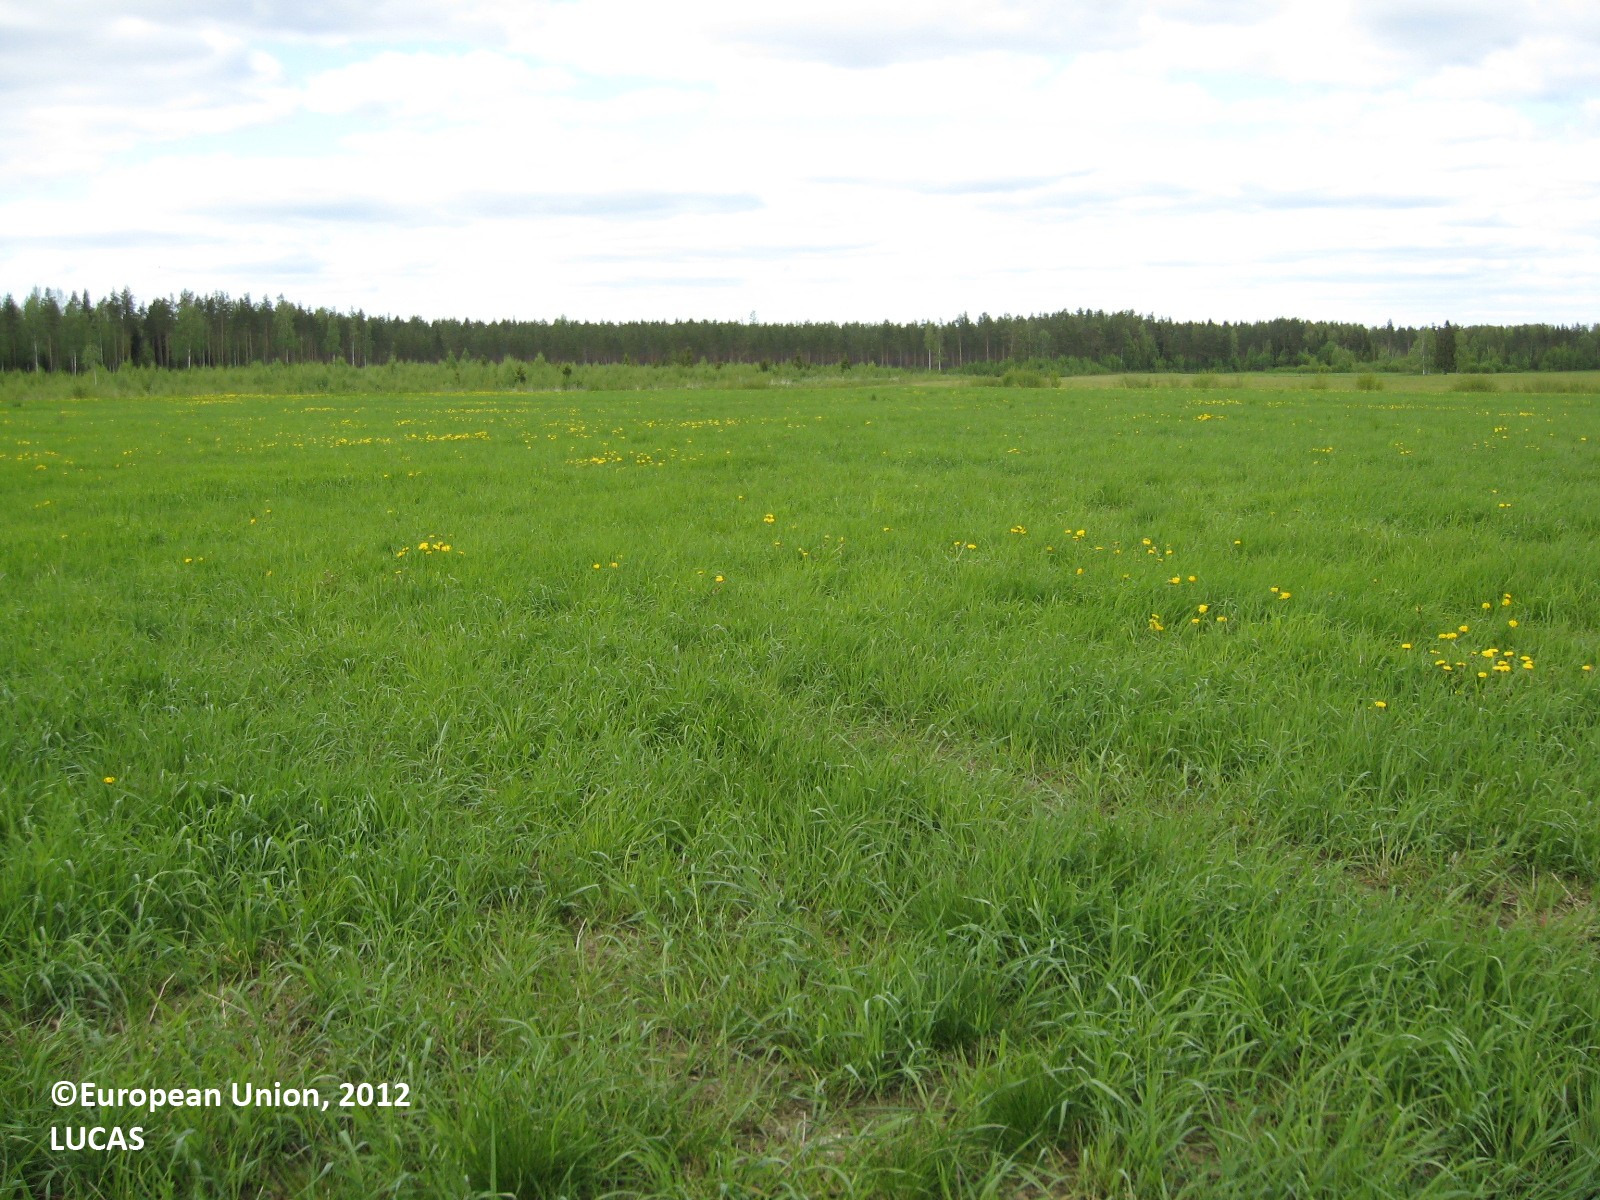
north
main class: Cropland
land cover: Temporary grasslands
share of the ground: > 75 %
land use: Agriculture (excluding fallow land and kitchen gardens)
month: May
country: FI
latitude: 61.8122
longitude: 22.5295
